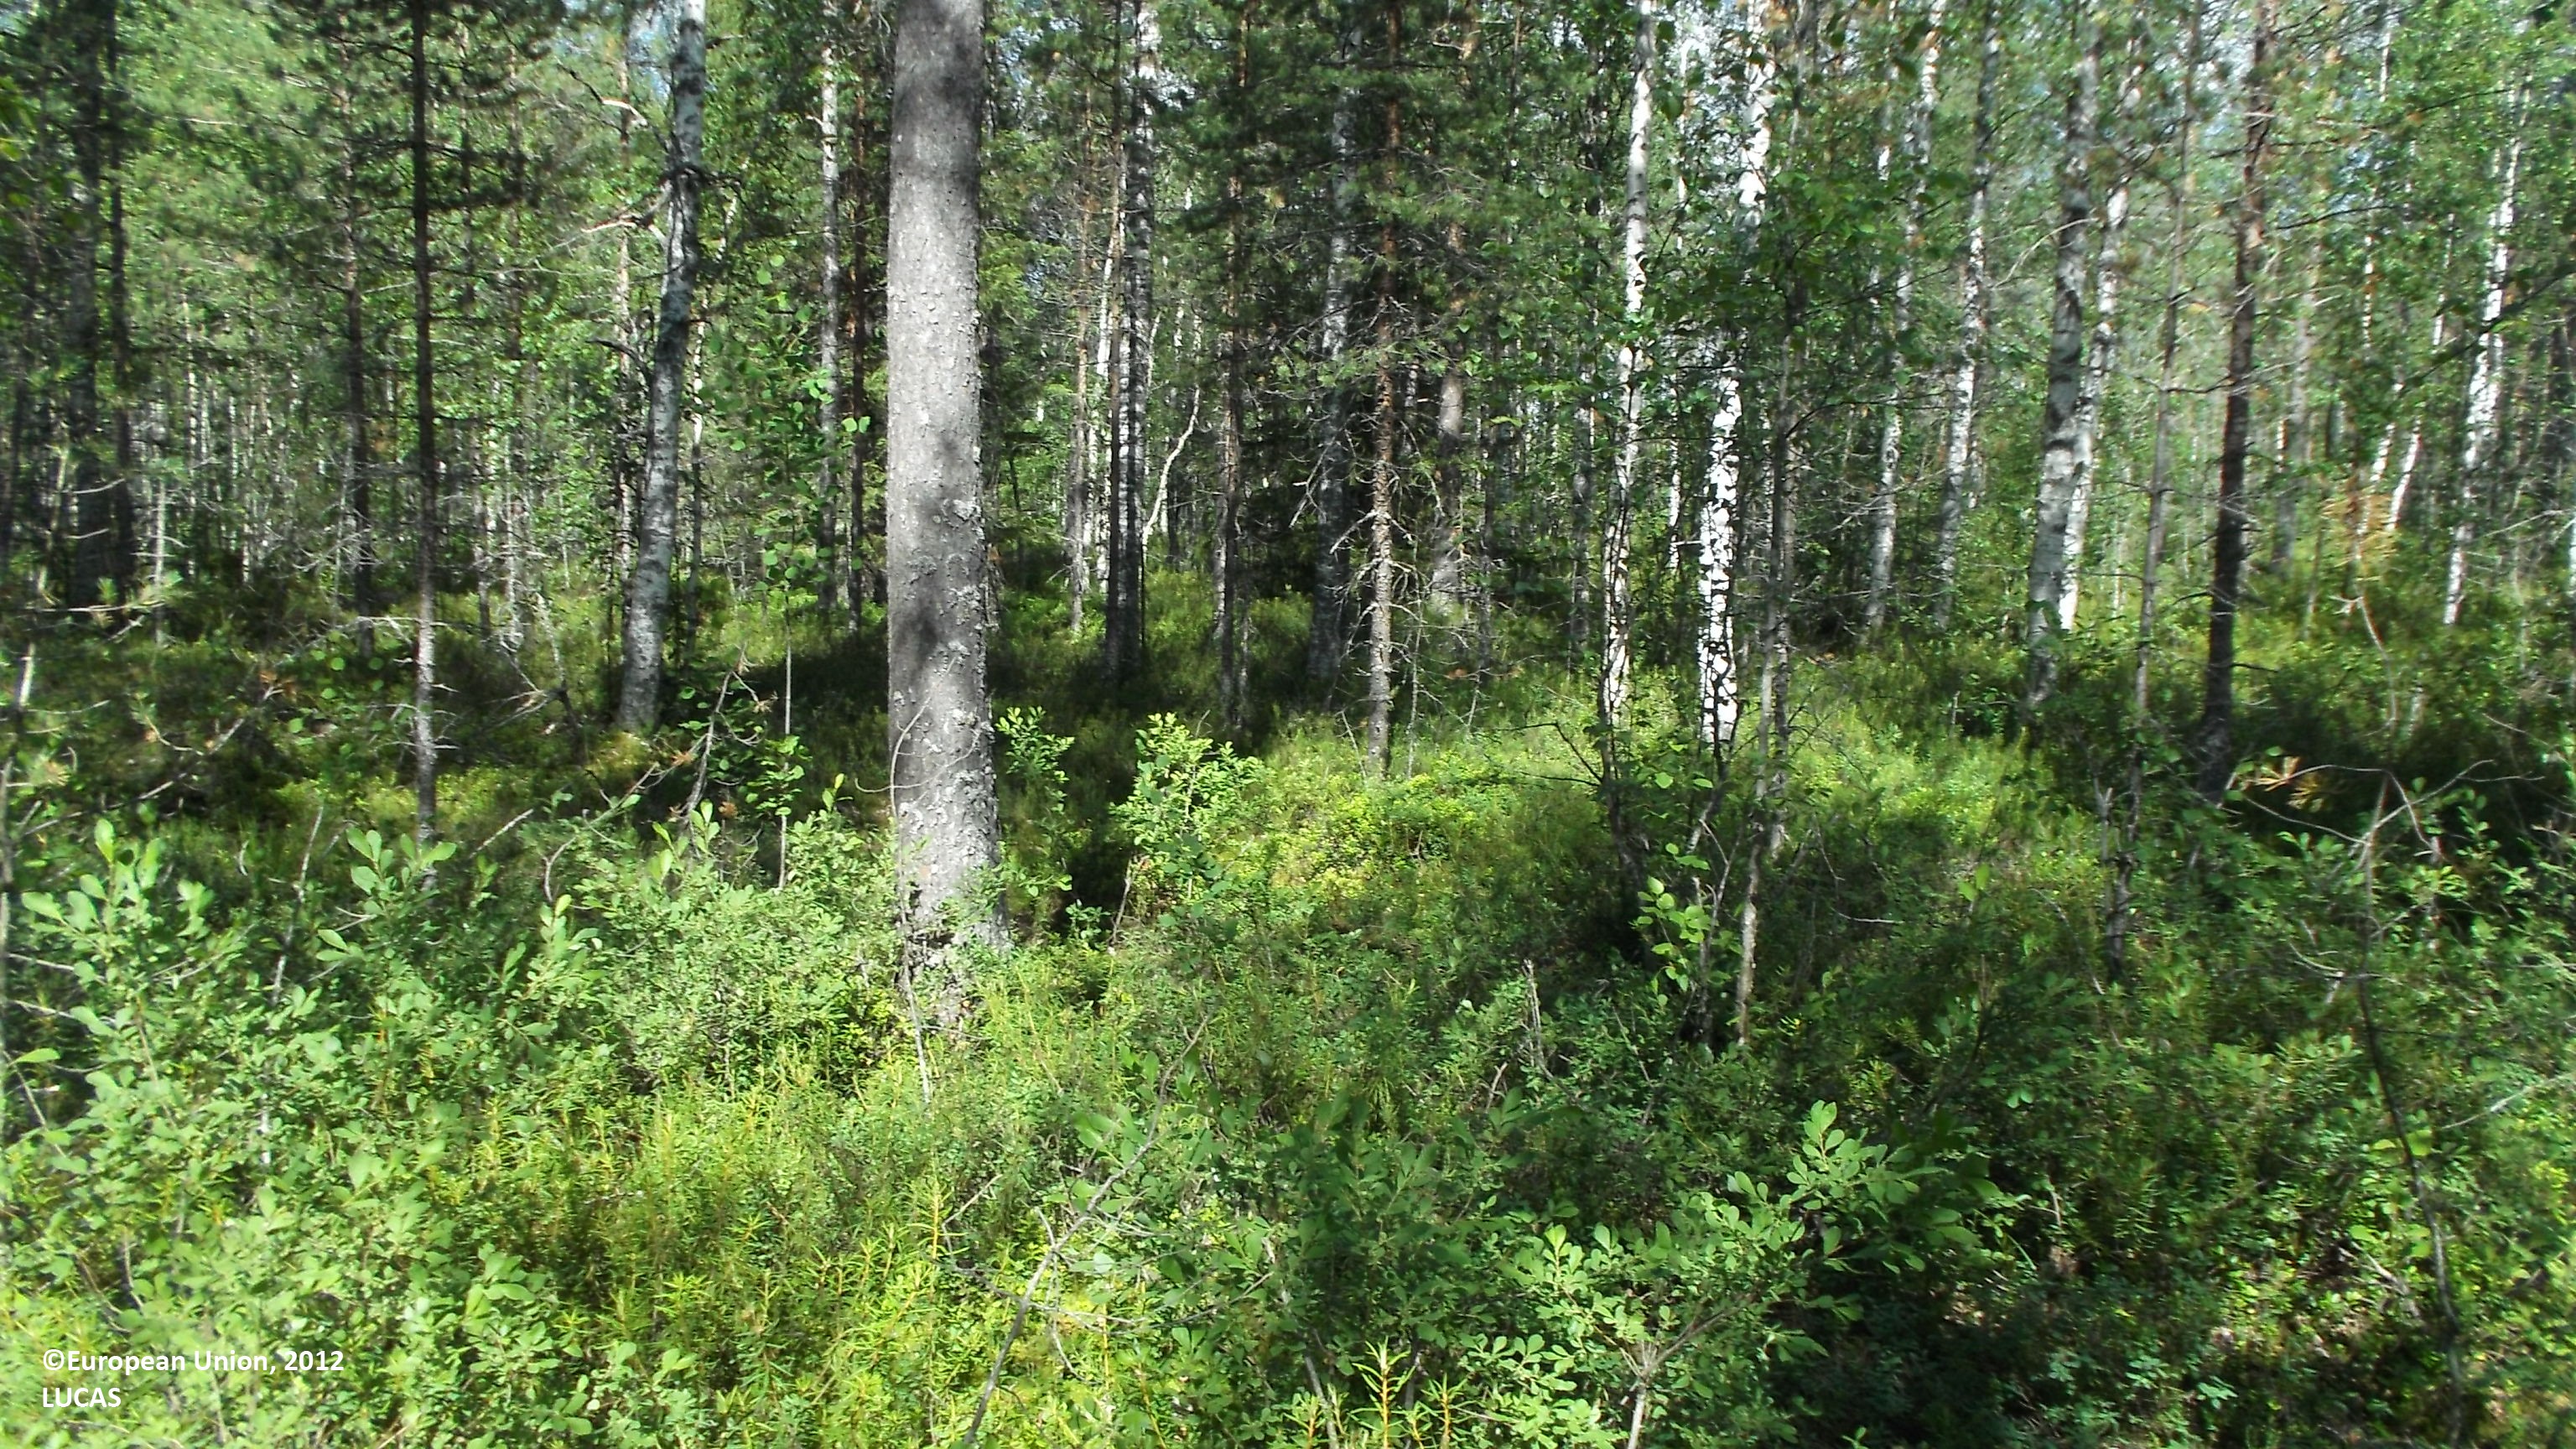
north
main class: Woodland
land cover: Pine dominated mixed woodland
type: boreal forest
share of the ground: 25 - 50 %
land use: Forestry
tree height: > 5 m
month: July
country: FI
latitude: 63.6149
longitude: 23.9240
